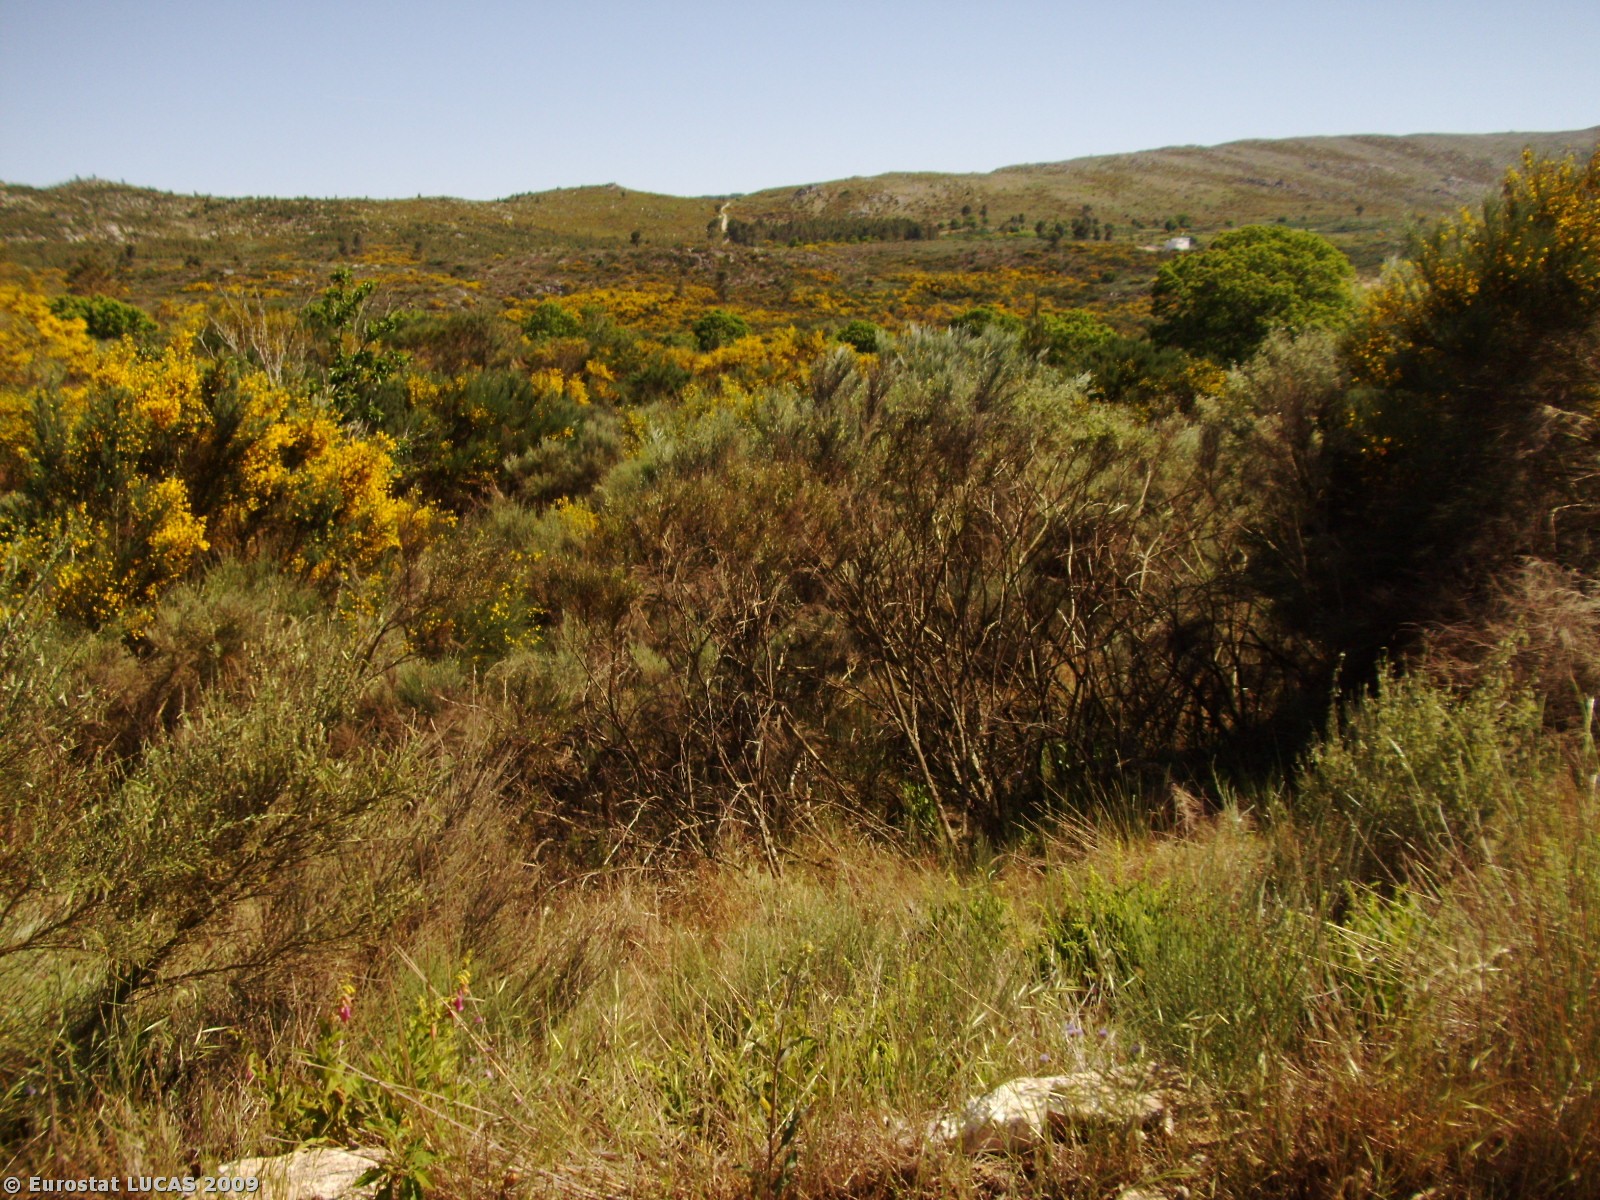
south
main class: Cropland
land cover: Nuts trees
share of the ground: 25 - 50 %
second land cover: Bare land
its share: 25 - 50 %
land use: Agriculture (excluding fallow land and kitchen gardens)
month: May
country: PT
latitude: 40.9032
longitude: -7.5579
